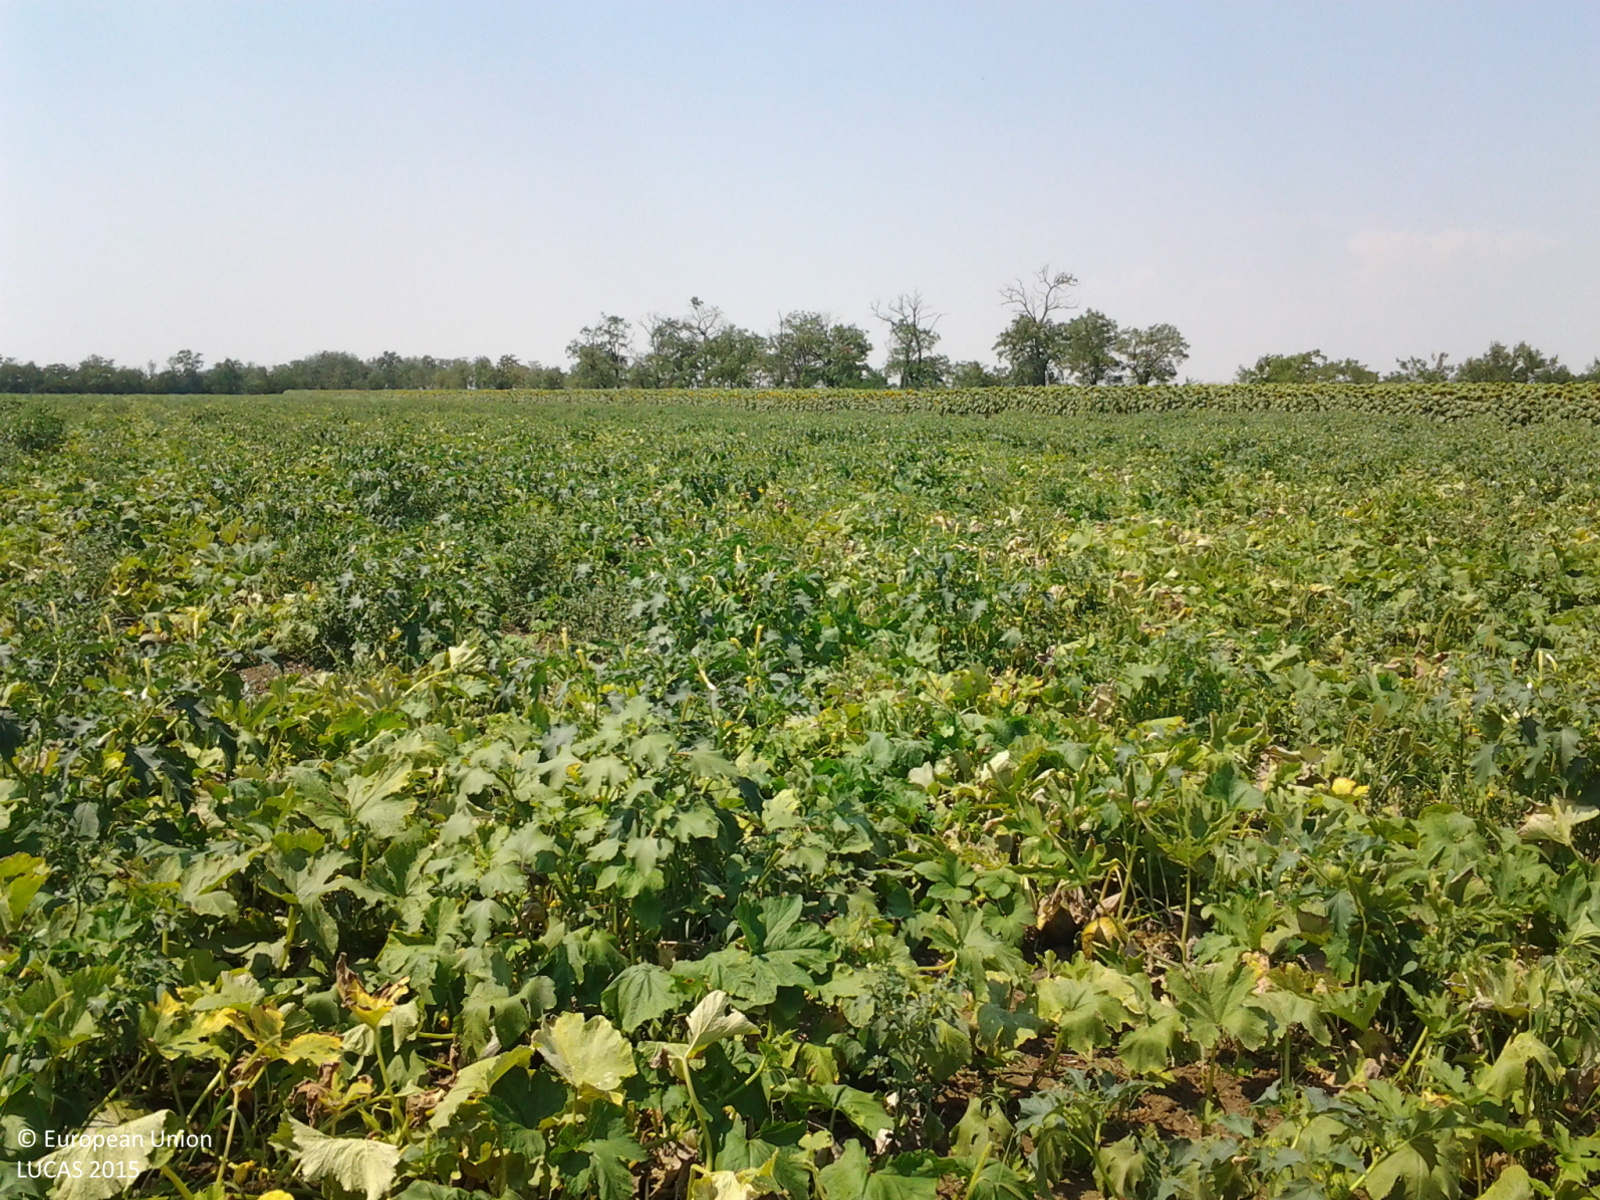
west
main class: Cropland
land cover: Other fresh vegetables
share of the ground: > 75 %
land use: Agriculture (excluding fallow land and kitchen gardens)
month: July
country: HU
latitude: 47.2531
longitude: 20.6420
